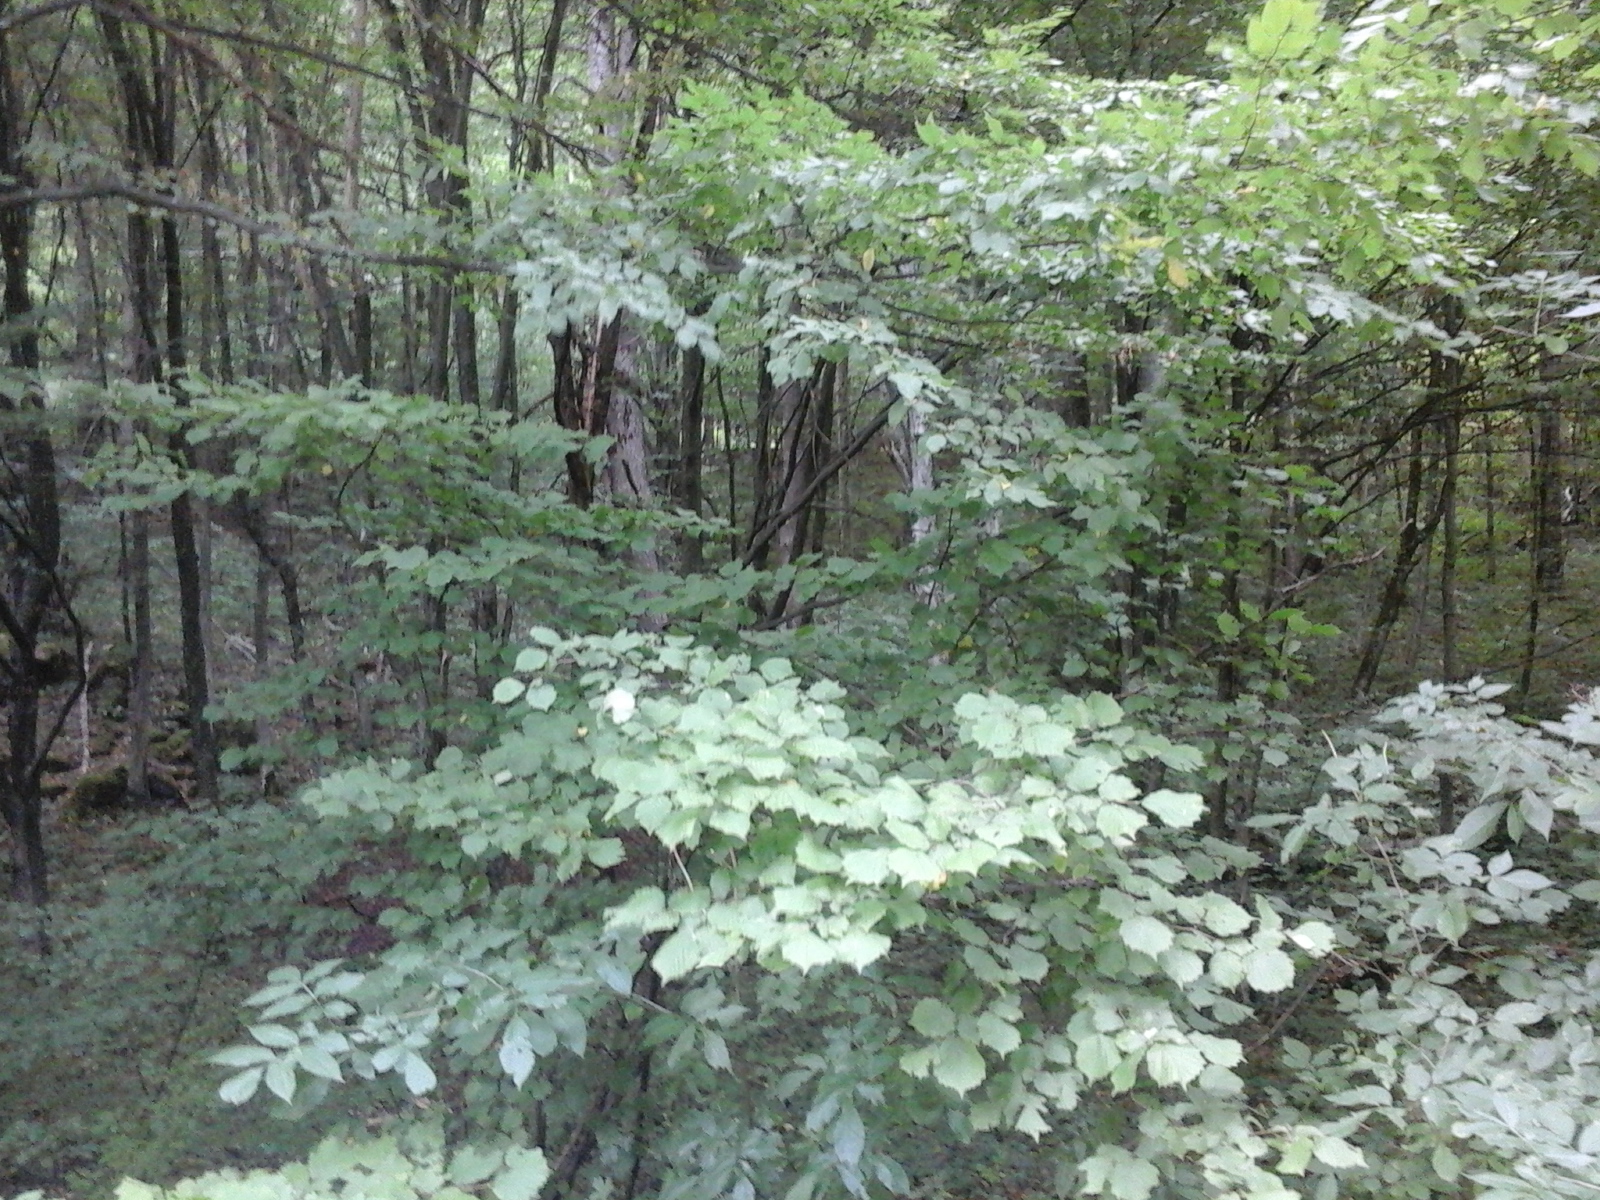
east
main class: Woodland
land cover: Broadleaved woodland
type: beech forest
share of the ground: > 75 %
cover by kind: broadleaved forest trees 100 %
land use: Forestry
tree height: > 5 m
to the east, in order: Broadleaved woodland; Tracks; Broadleaved woodland
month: August
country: RO
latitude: 45.1412
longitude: 21.8742
